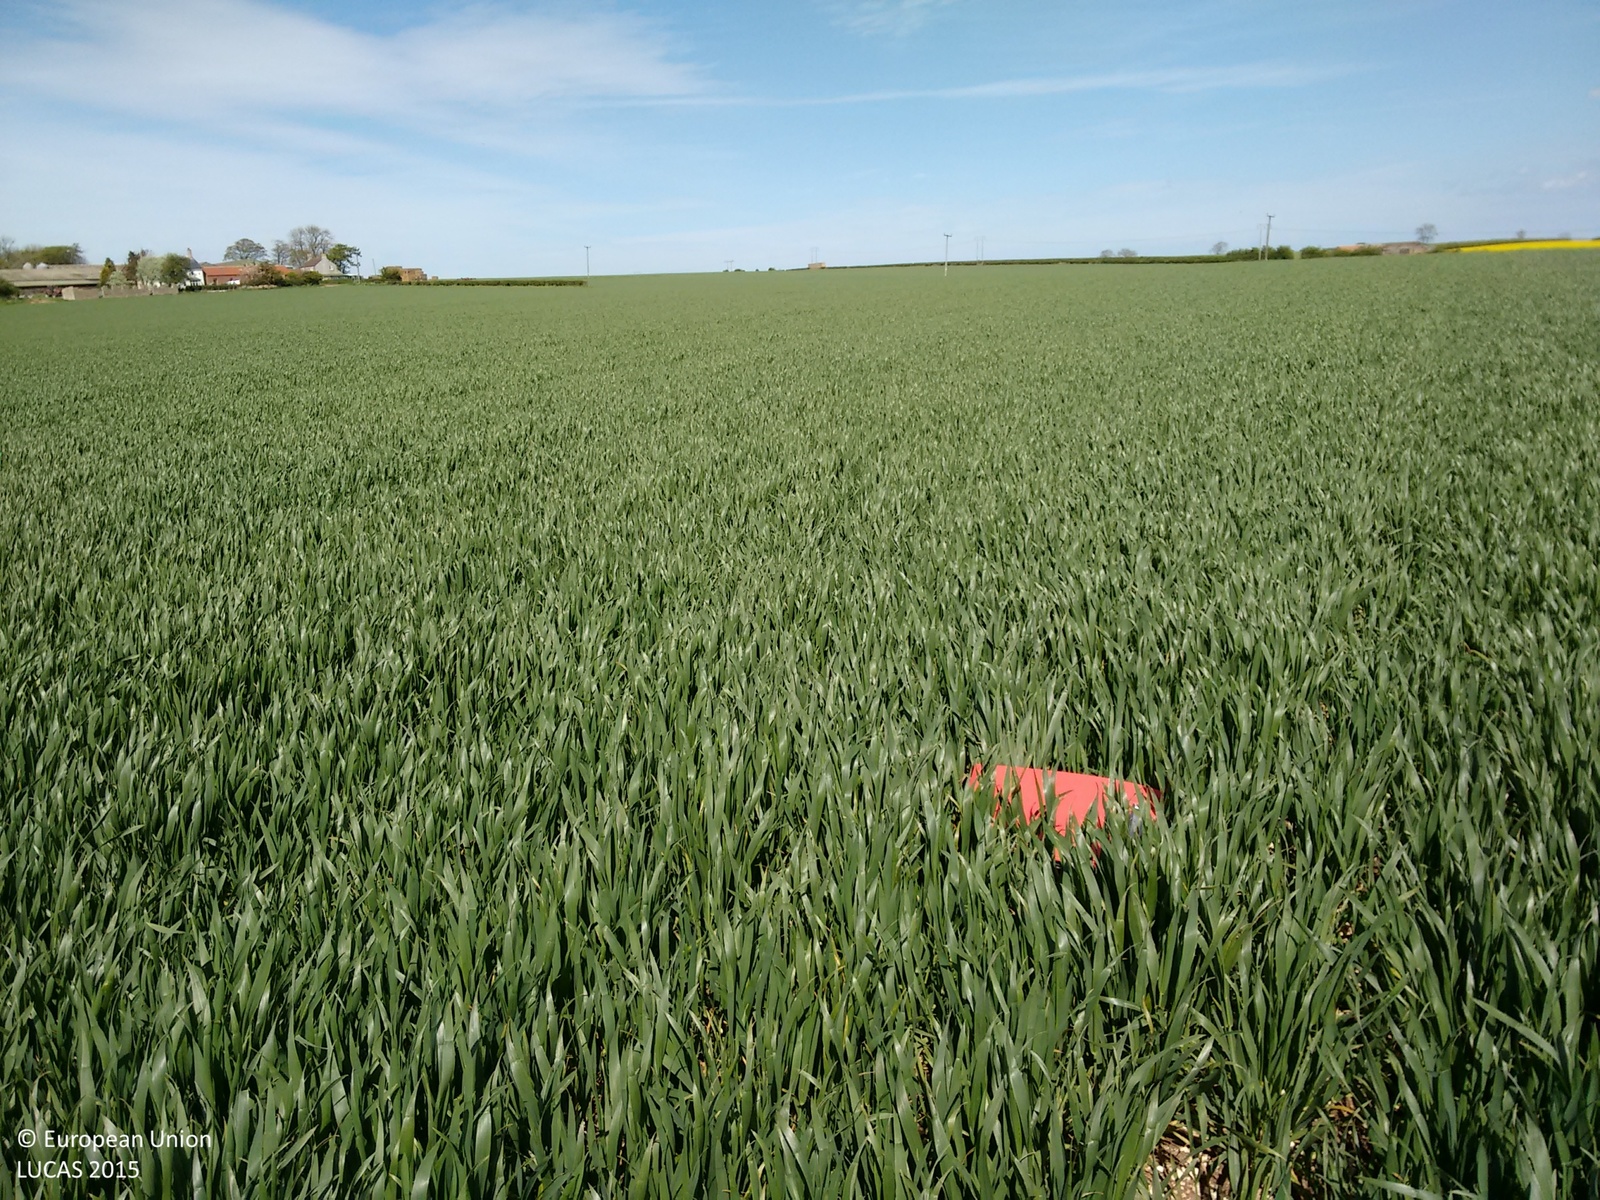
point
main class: Cropland
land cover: Common wheat
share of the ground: > 75 %
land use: Agriculture (excluding fallow land and kitchen gardens)
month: May
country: GB
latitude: 54.1167
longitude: -0.3613
